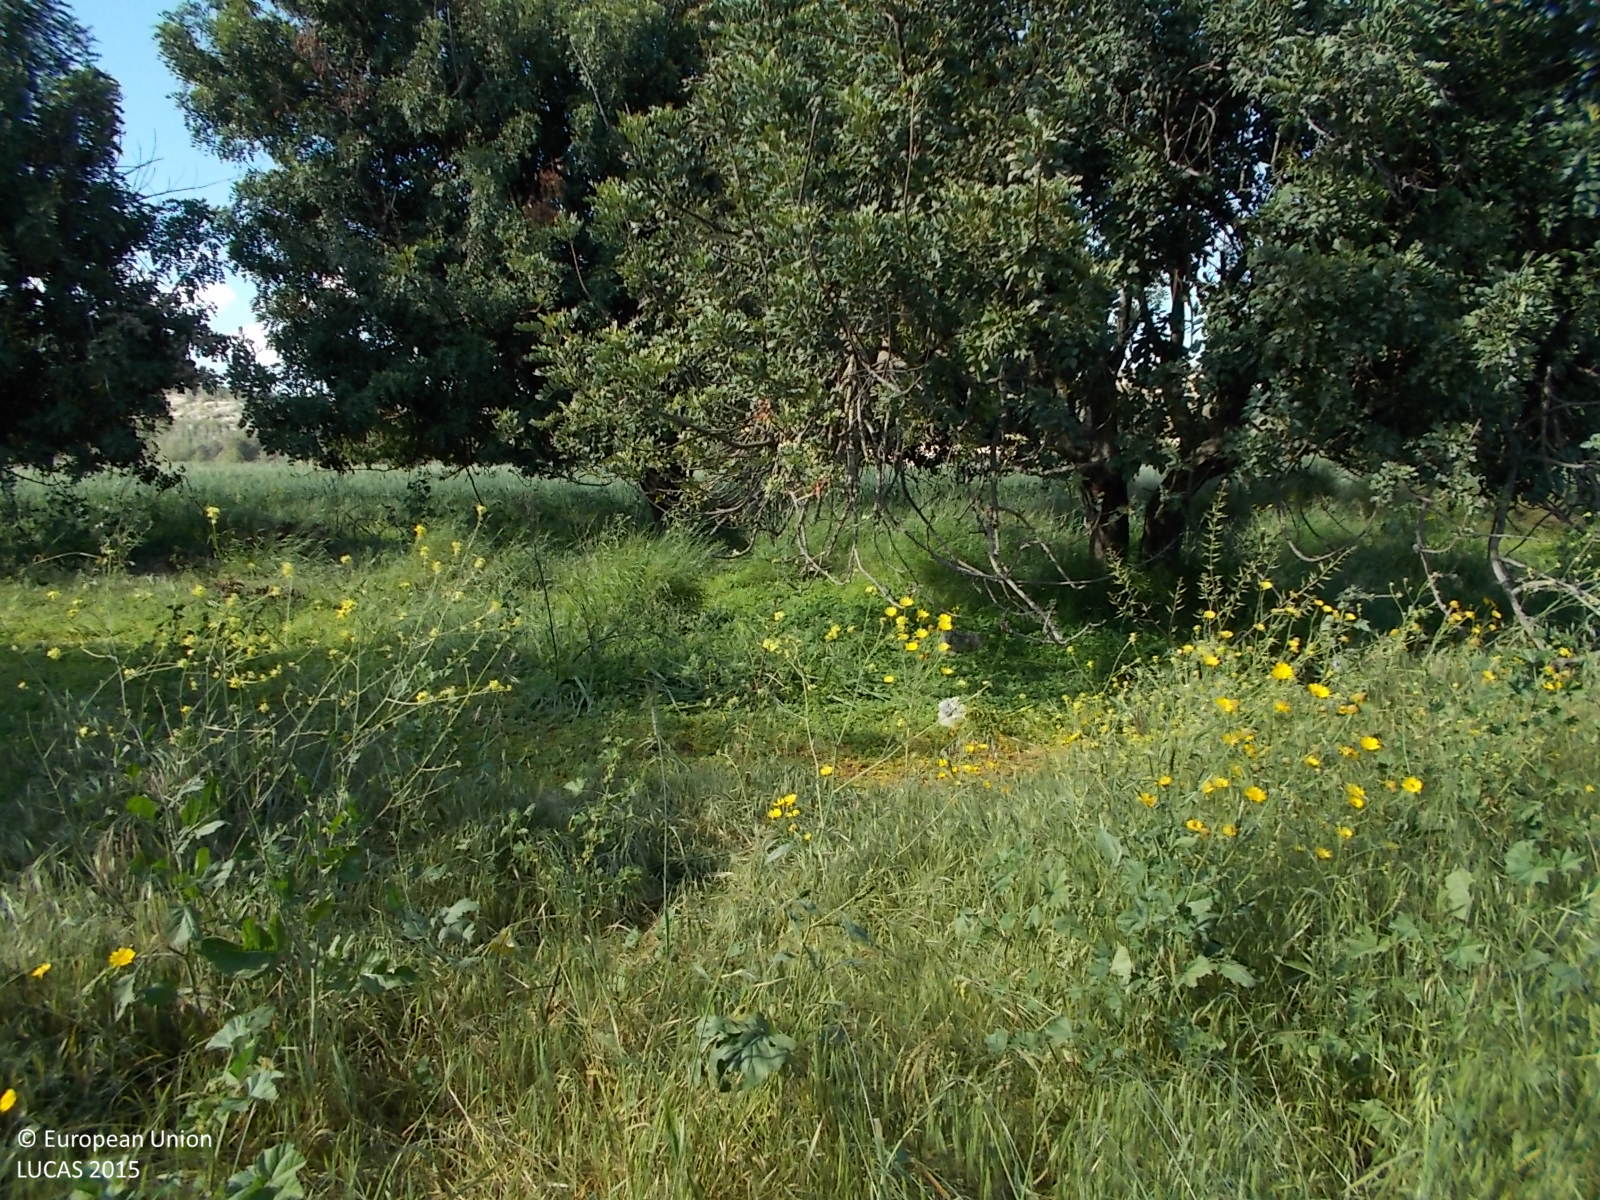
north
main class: Cropland
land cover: Other fruit trees and berries
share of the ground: 50 - 75 %
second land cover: Spontaneously vegetated surfaces
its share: > 75 %
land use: Agriculture (excluding fallow land and kitchen gardens)
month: April
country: CY
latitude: 34.9798
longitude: 33.5151
